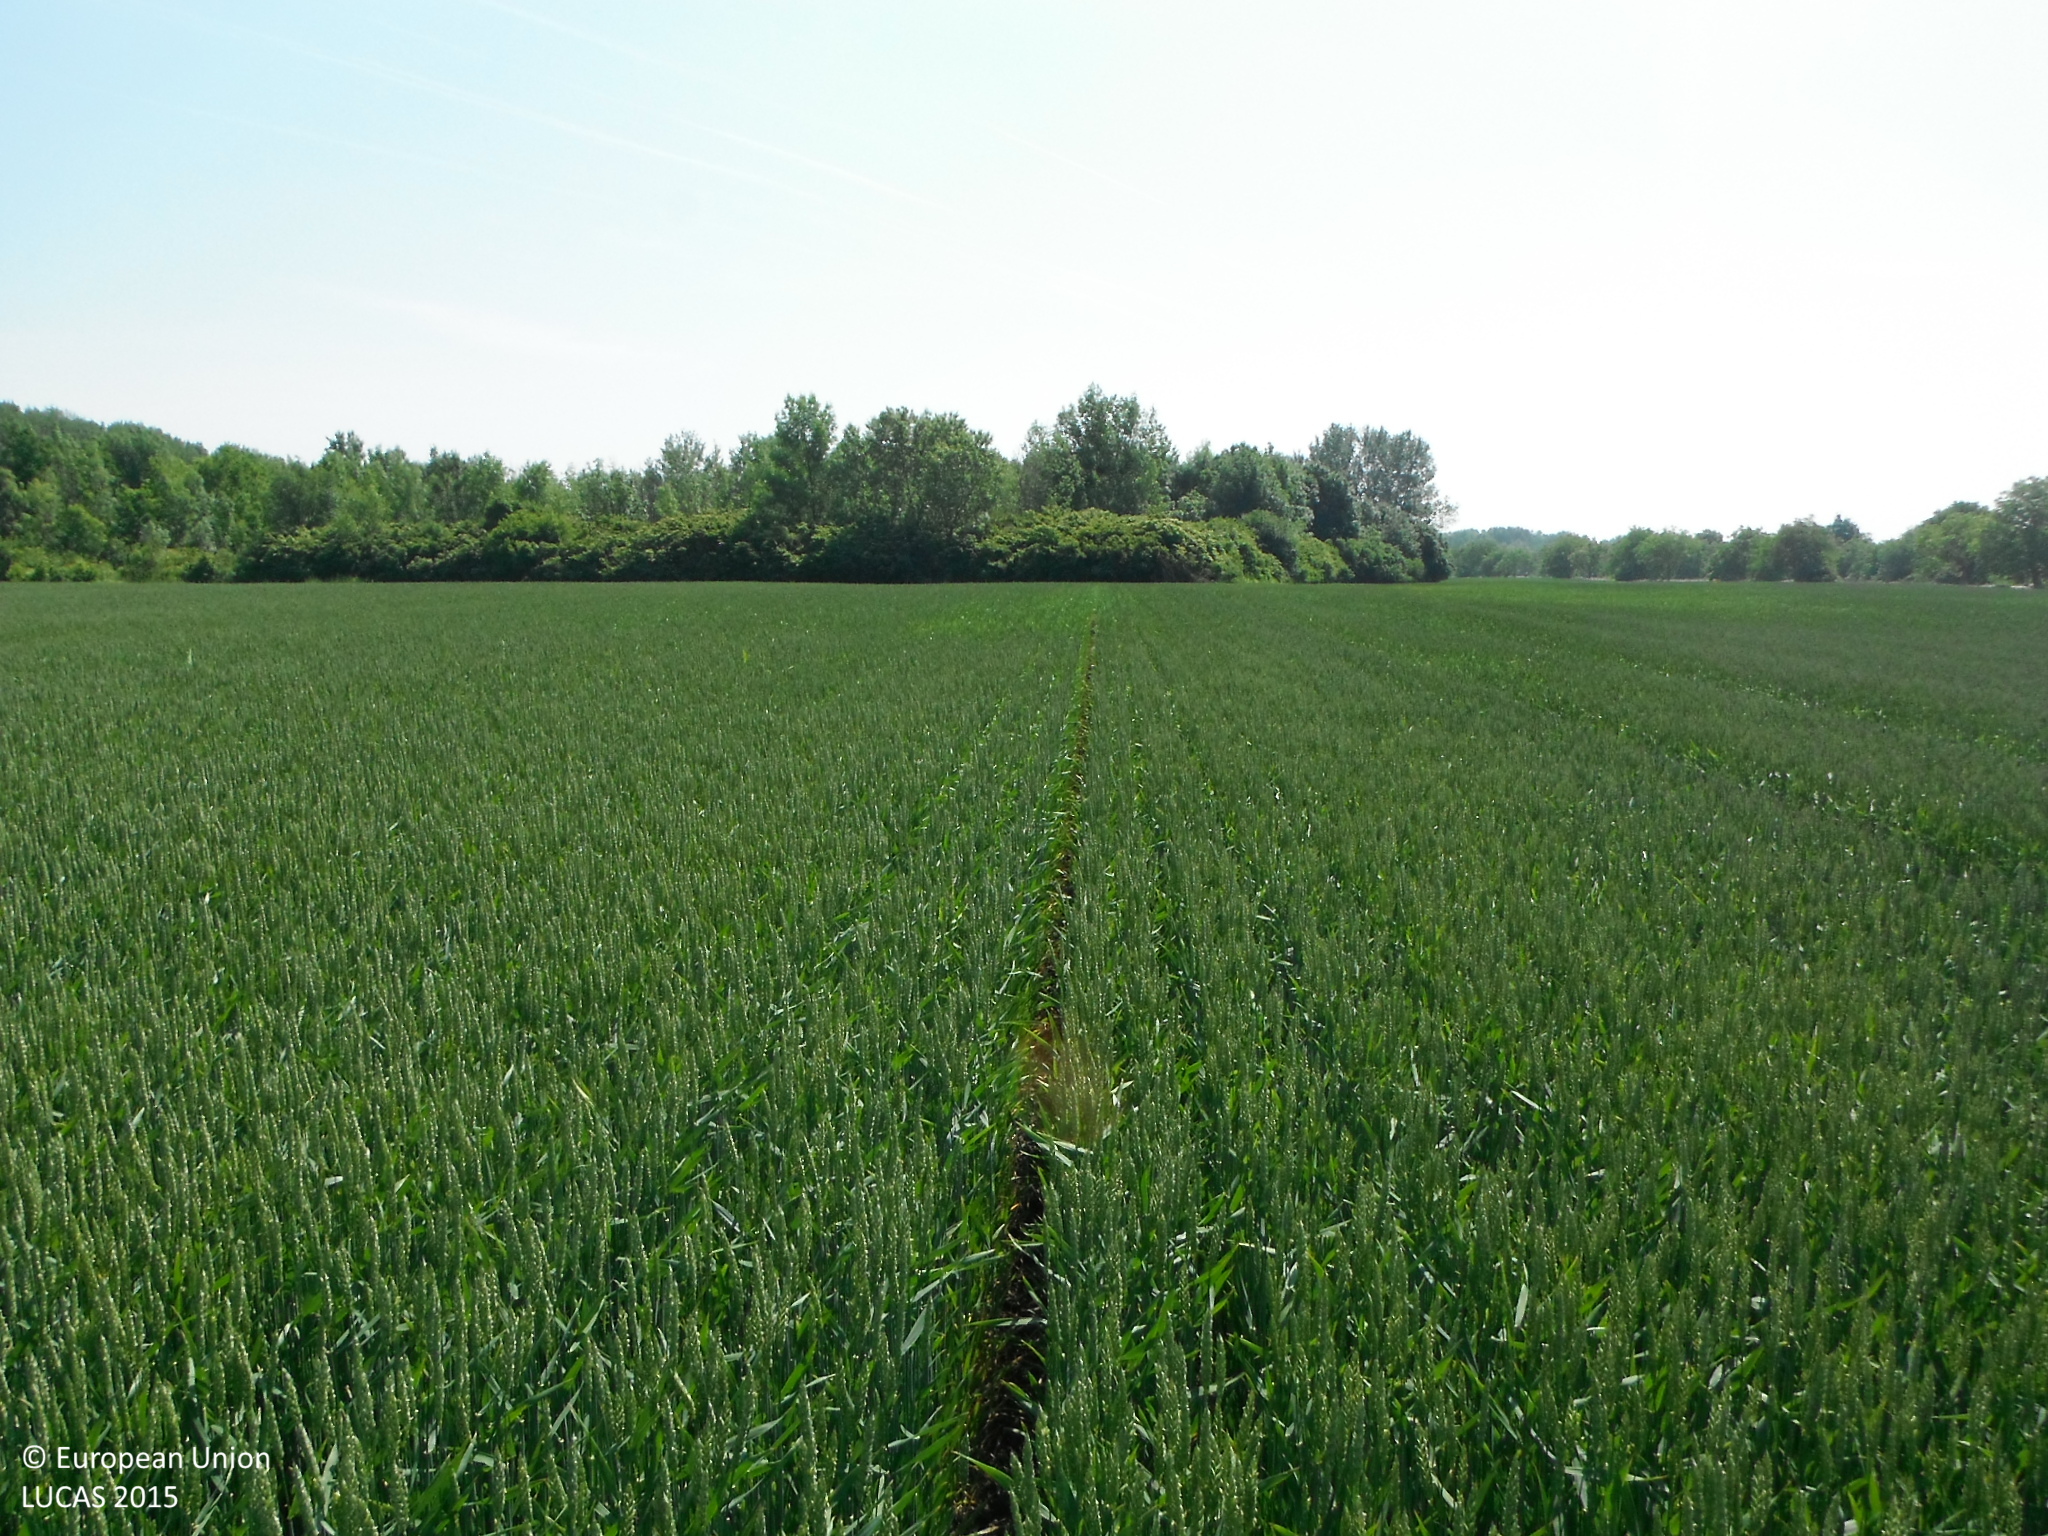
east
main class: Cropland
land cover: Common wheat
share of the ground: > 75 %
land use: Agriculture (excluding fallow land and kitchen gardens)
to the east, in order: Common wheat; Shrubland with sparse tree cover; Broadleaved woodland
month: May
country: SK
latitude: 48.1970
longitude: 17.5849
